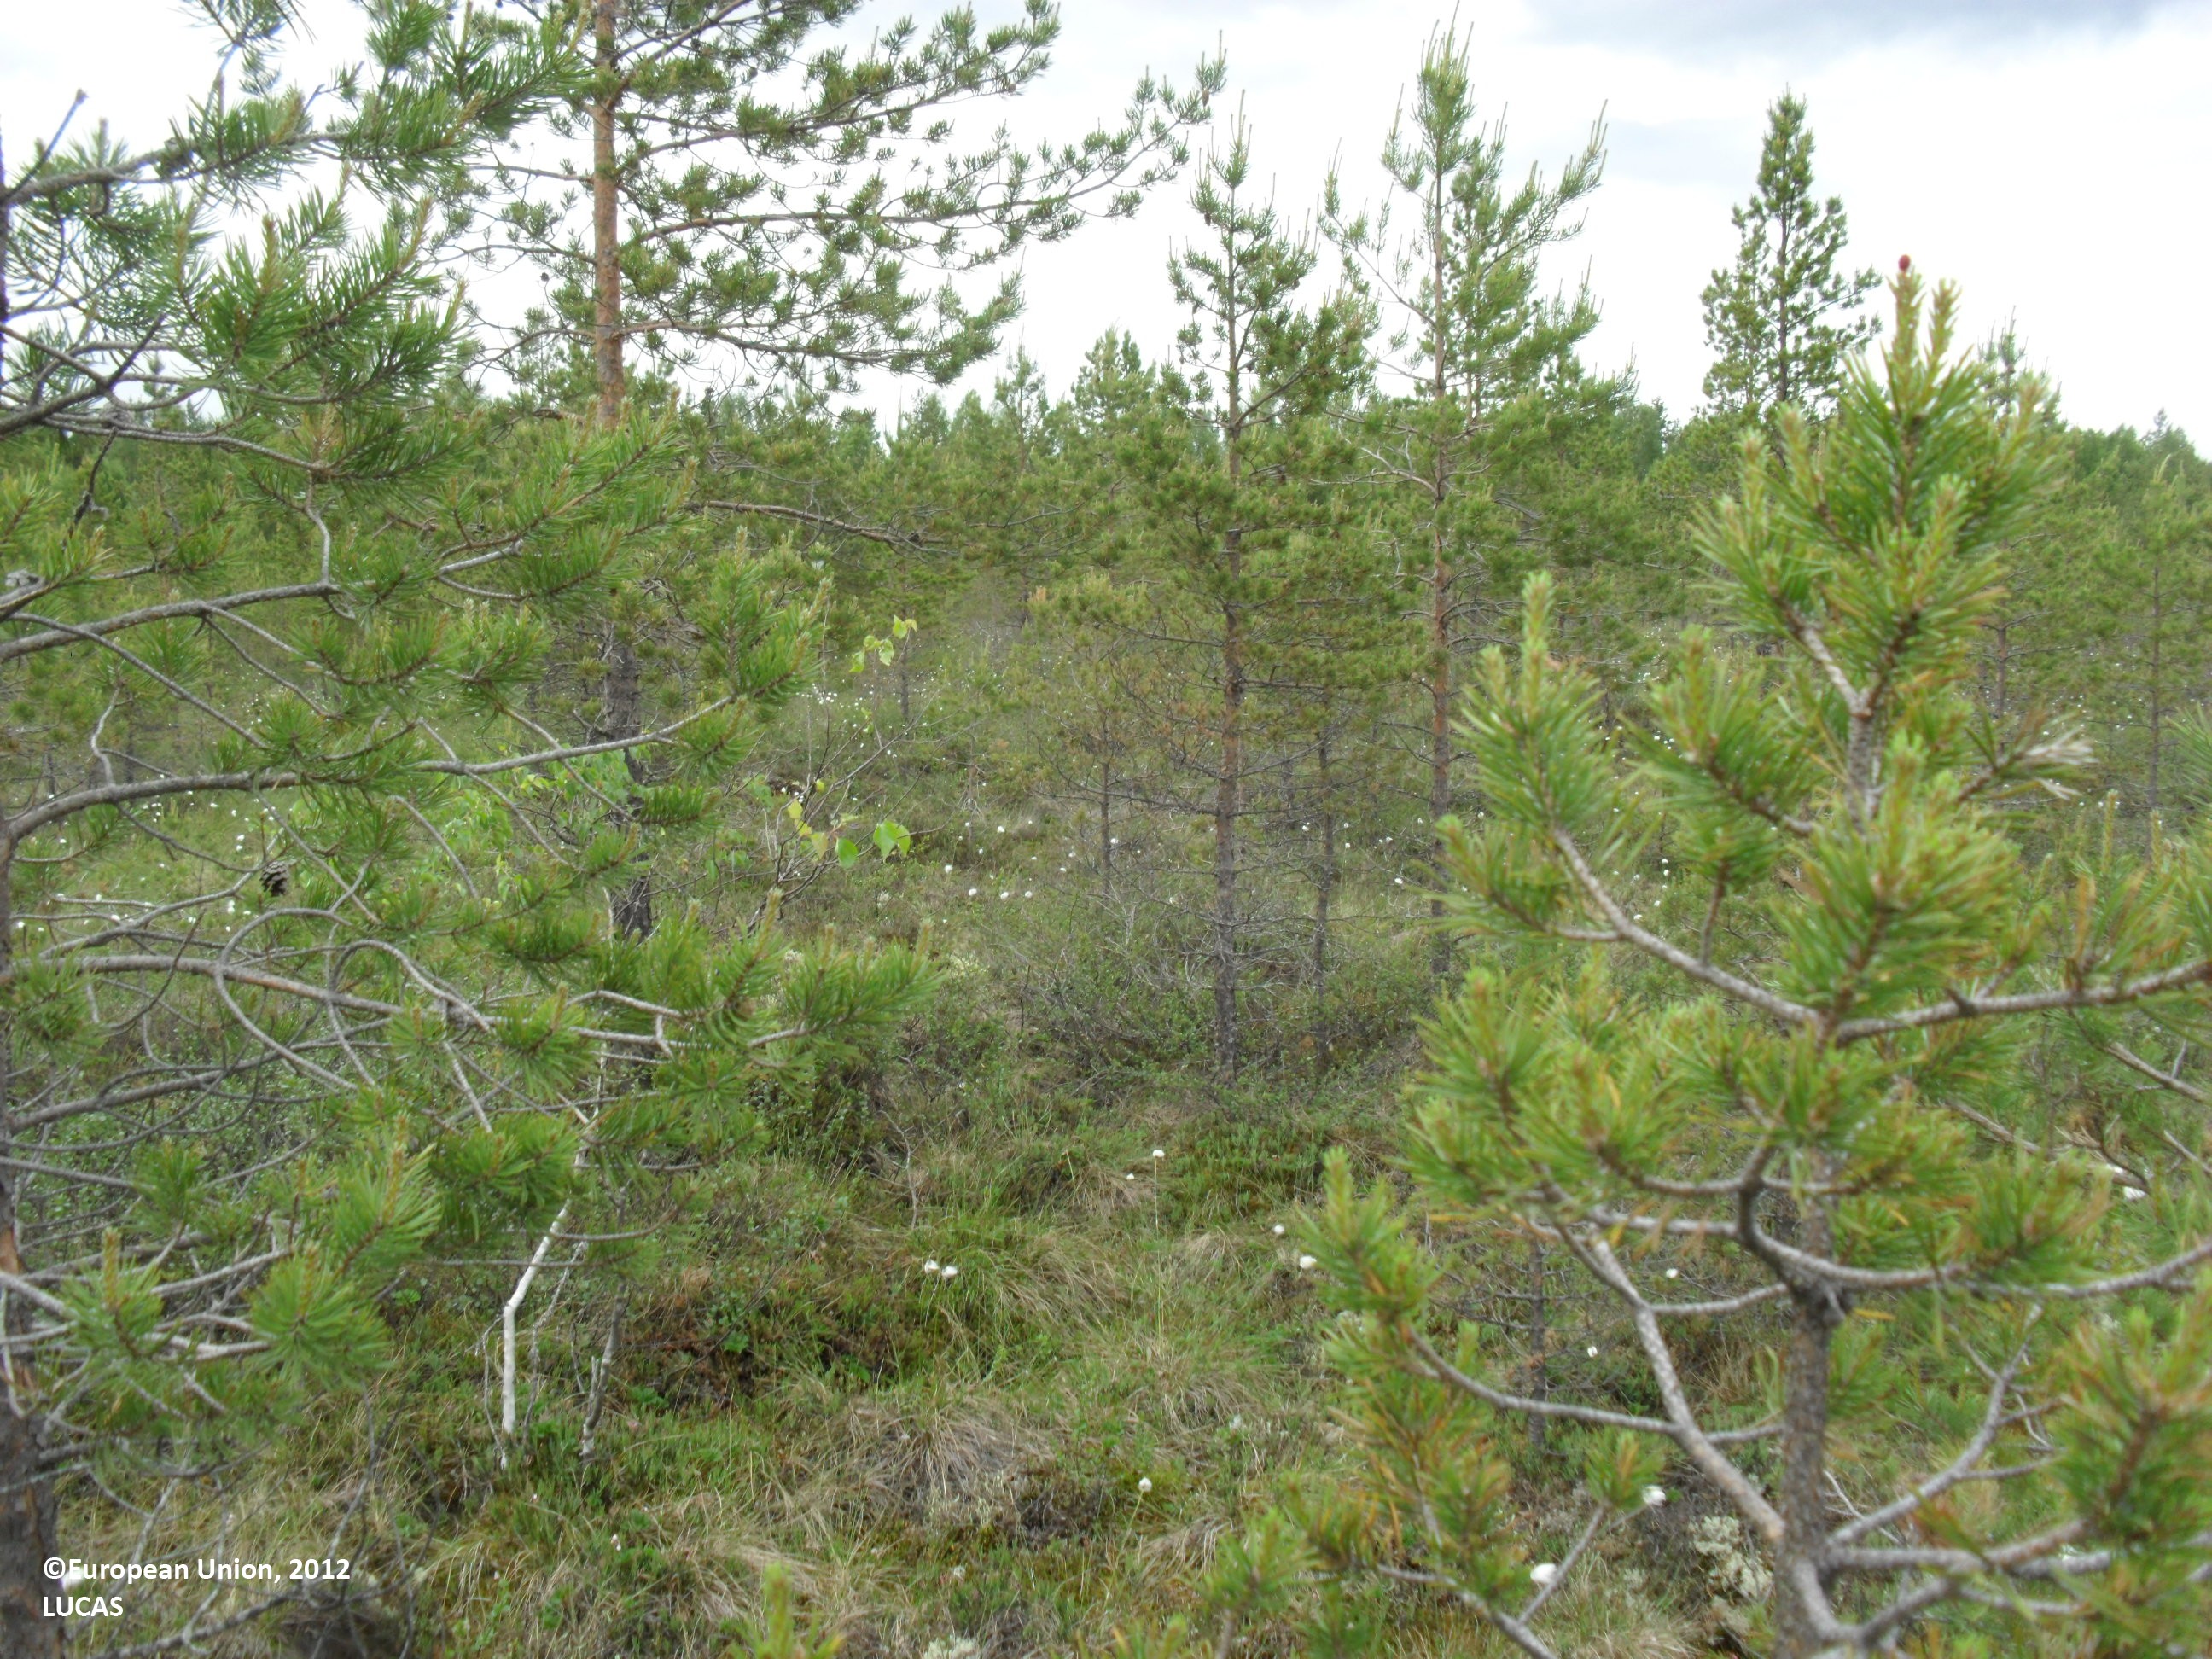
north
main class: Woodland
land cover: Pine dominated coniferous woodland
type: mire and swamp forests
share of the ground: 10 - 25 %
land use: Forestry
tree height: < 5 m
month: June
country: FI
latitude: 63.1762
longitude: 23.0687
